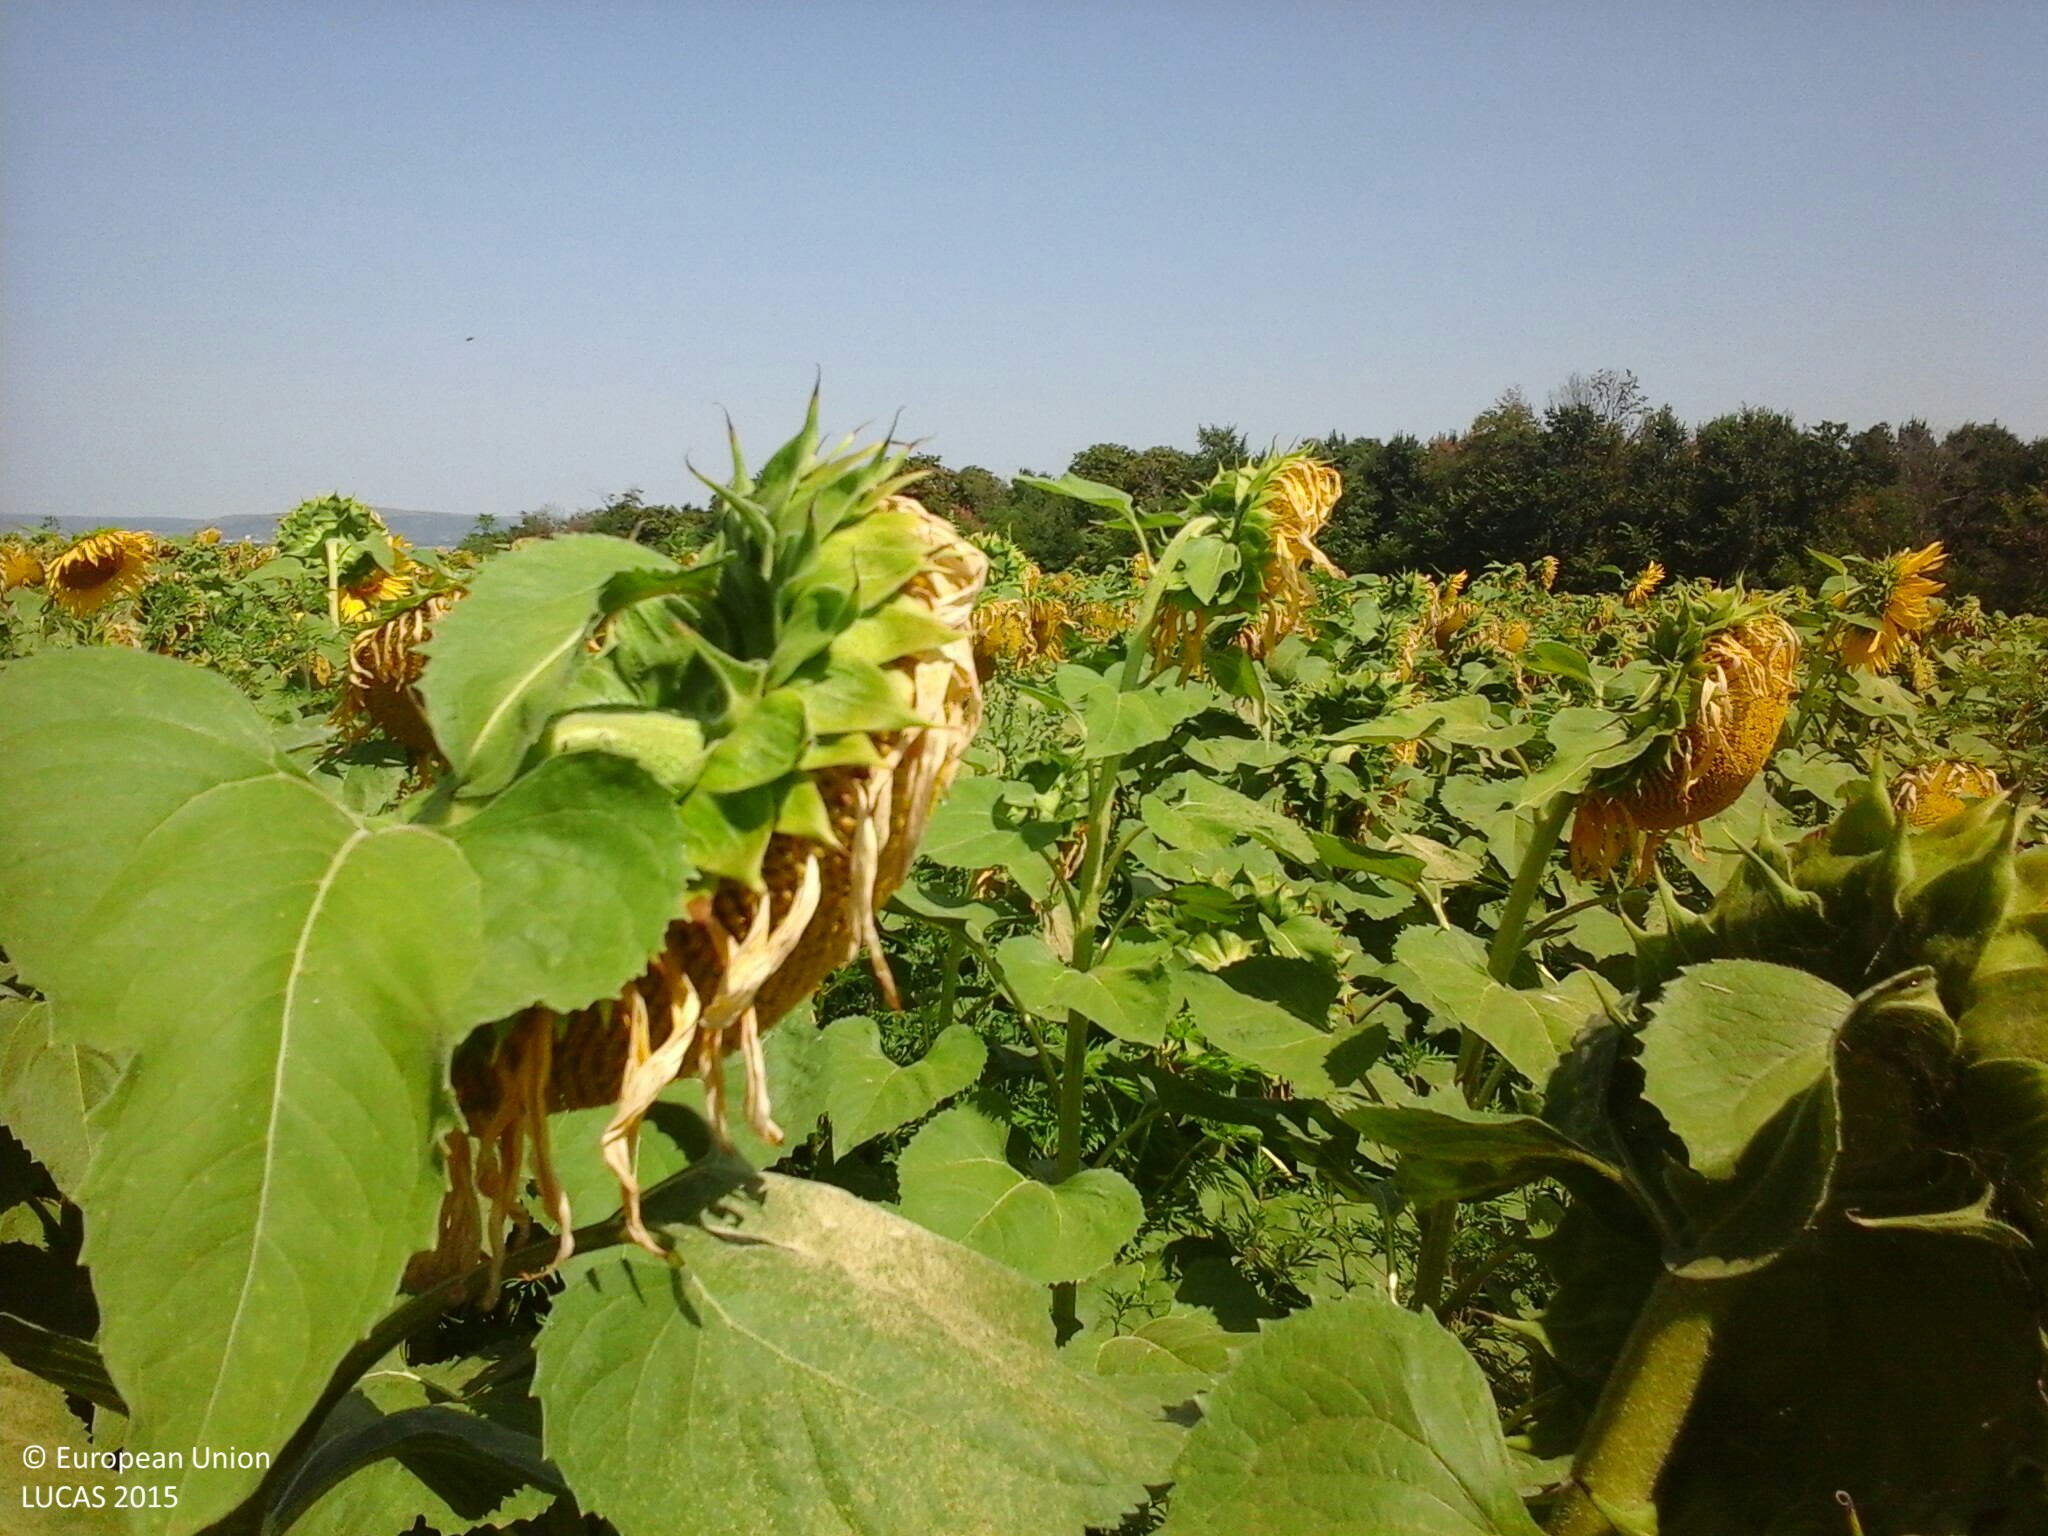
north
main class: Cropland
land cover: Sunflower
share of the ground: > 75 %
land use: Agriculture (excluding fallow land and kitchen gardens)
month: July
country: HU
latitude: 47.1181
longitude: 18.2486
